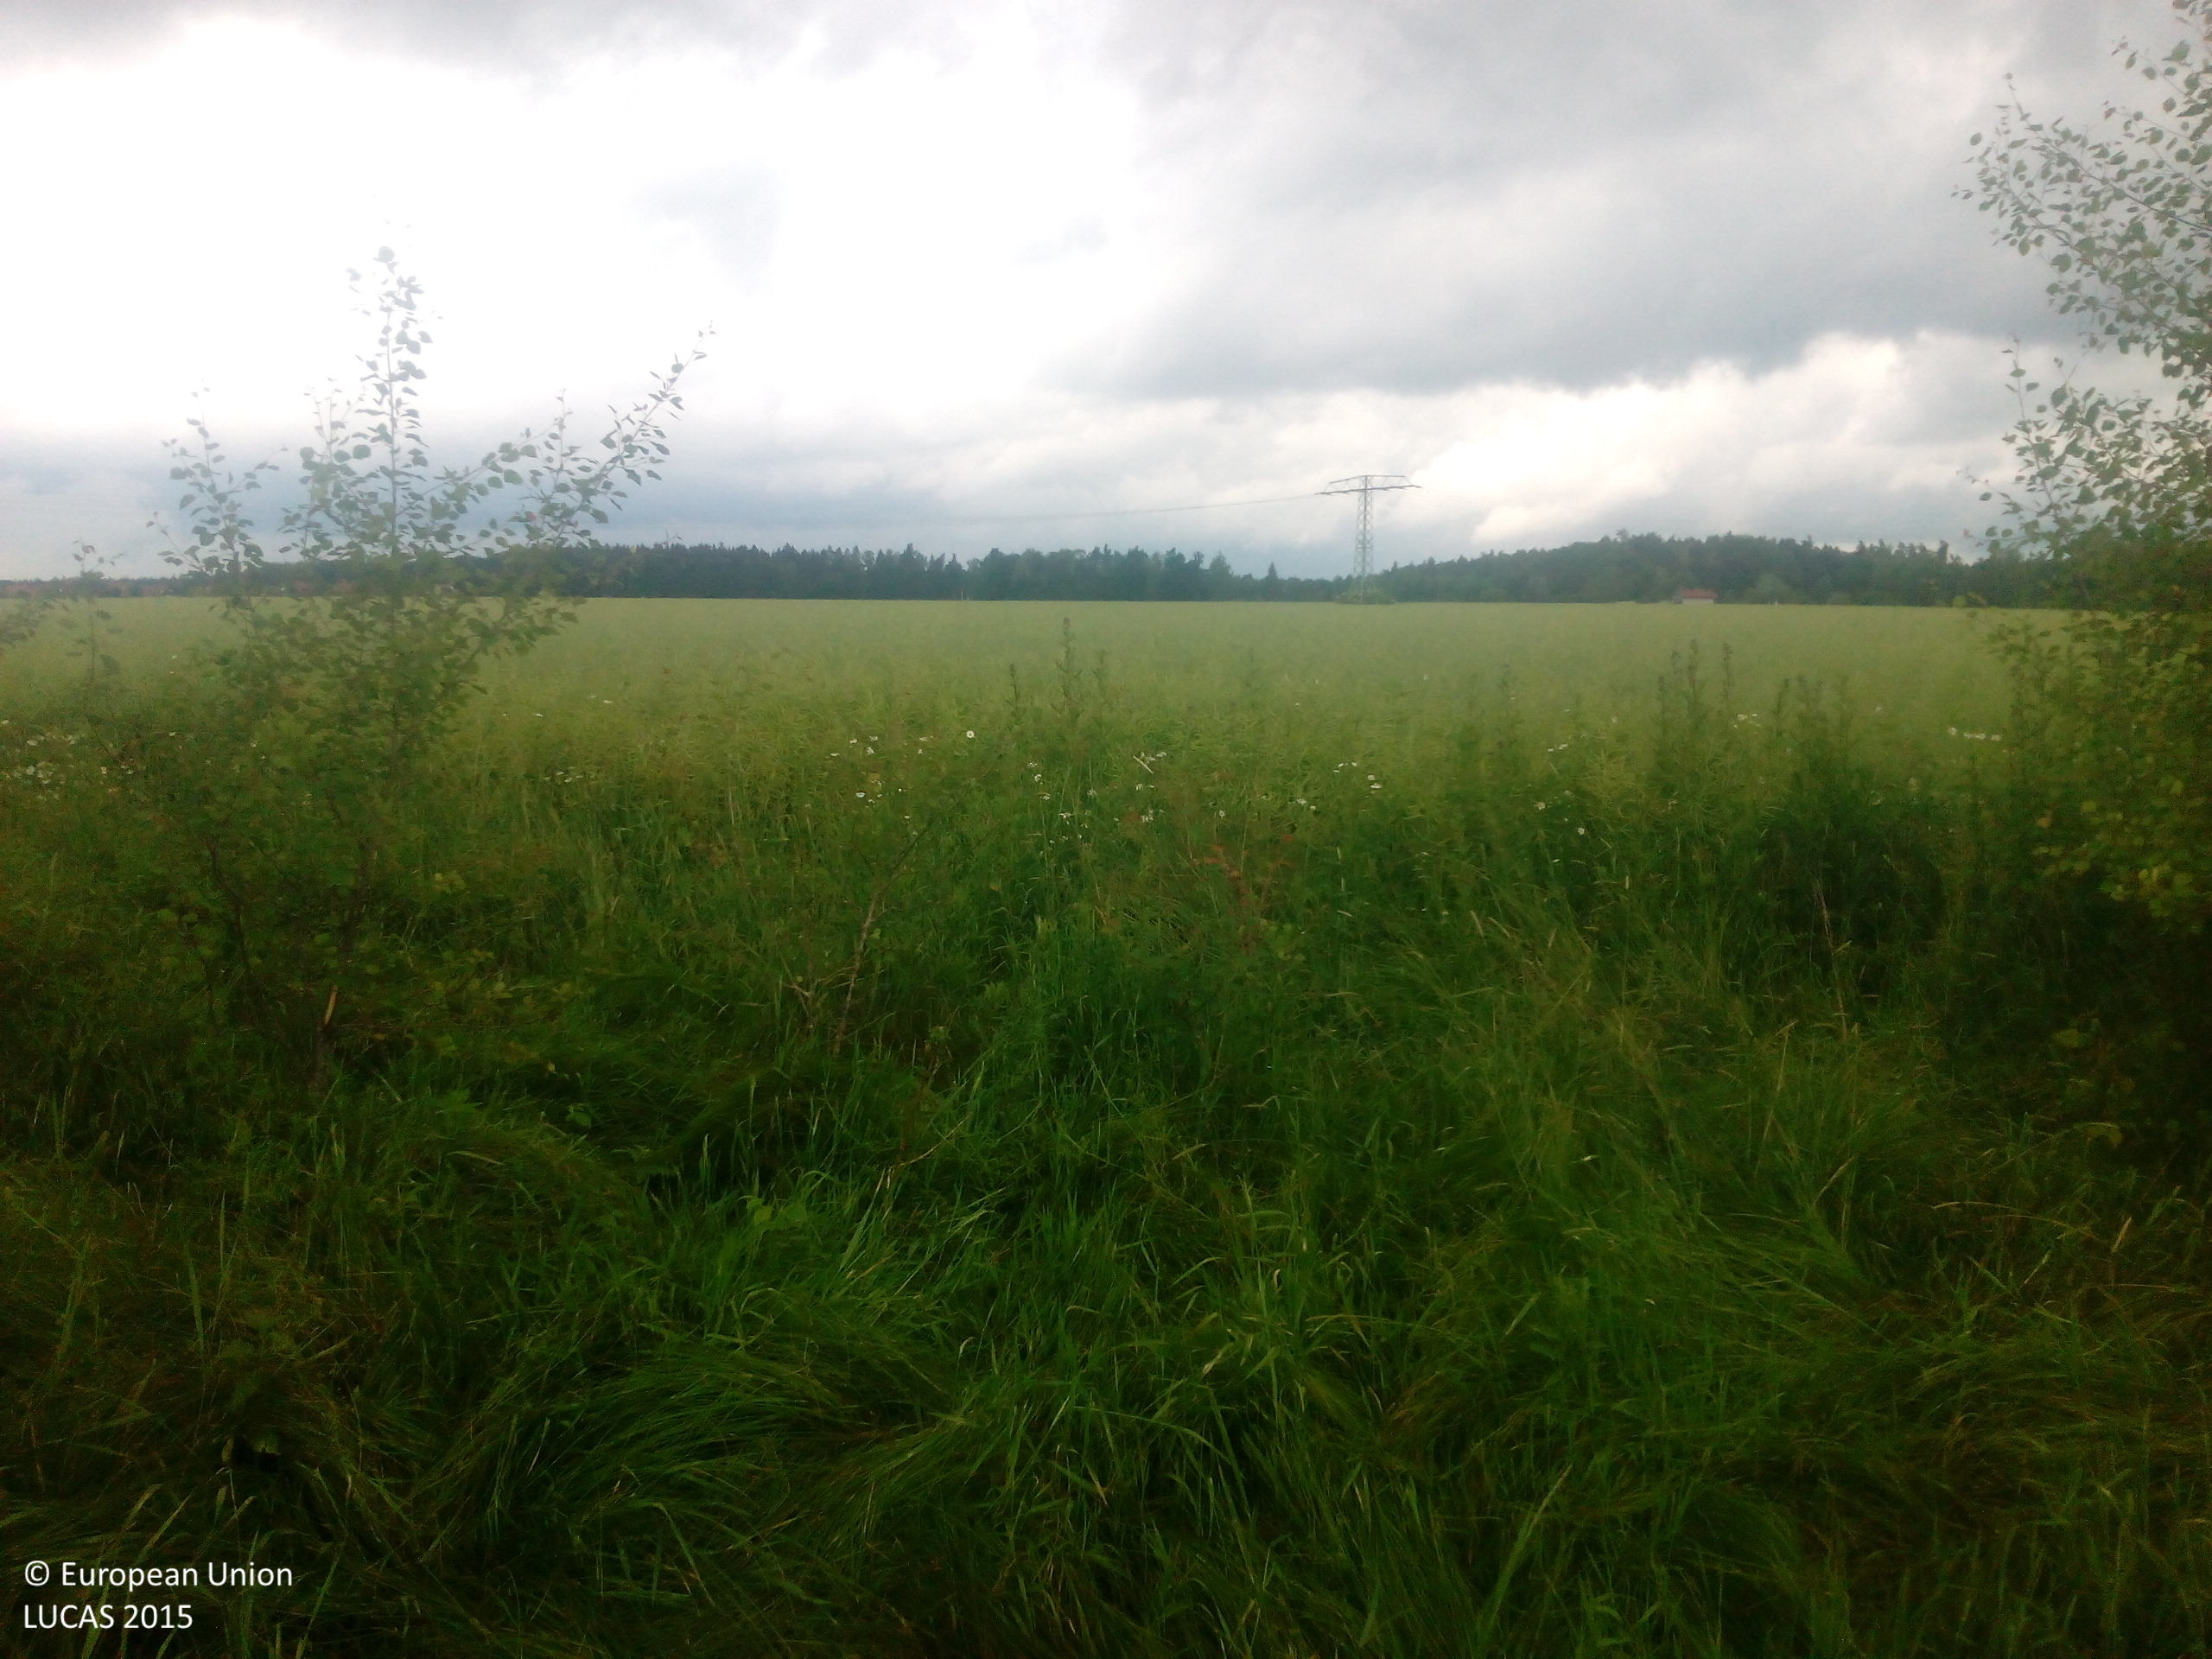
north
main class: Woodland
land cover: Broadleaved woodland
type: acidophilous oak and oak-birch forest
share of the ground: 25 - 50 %
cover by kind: broadleaved forest trees 50 %, shrubs 30 %, herbaceous plants 20 %
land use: Forestry
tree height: < 5 m
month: June
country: DE
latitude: 51.1227
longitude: 13.9872
